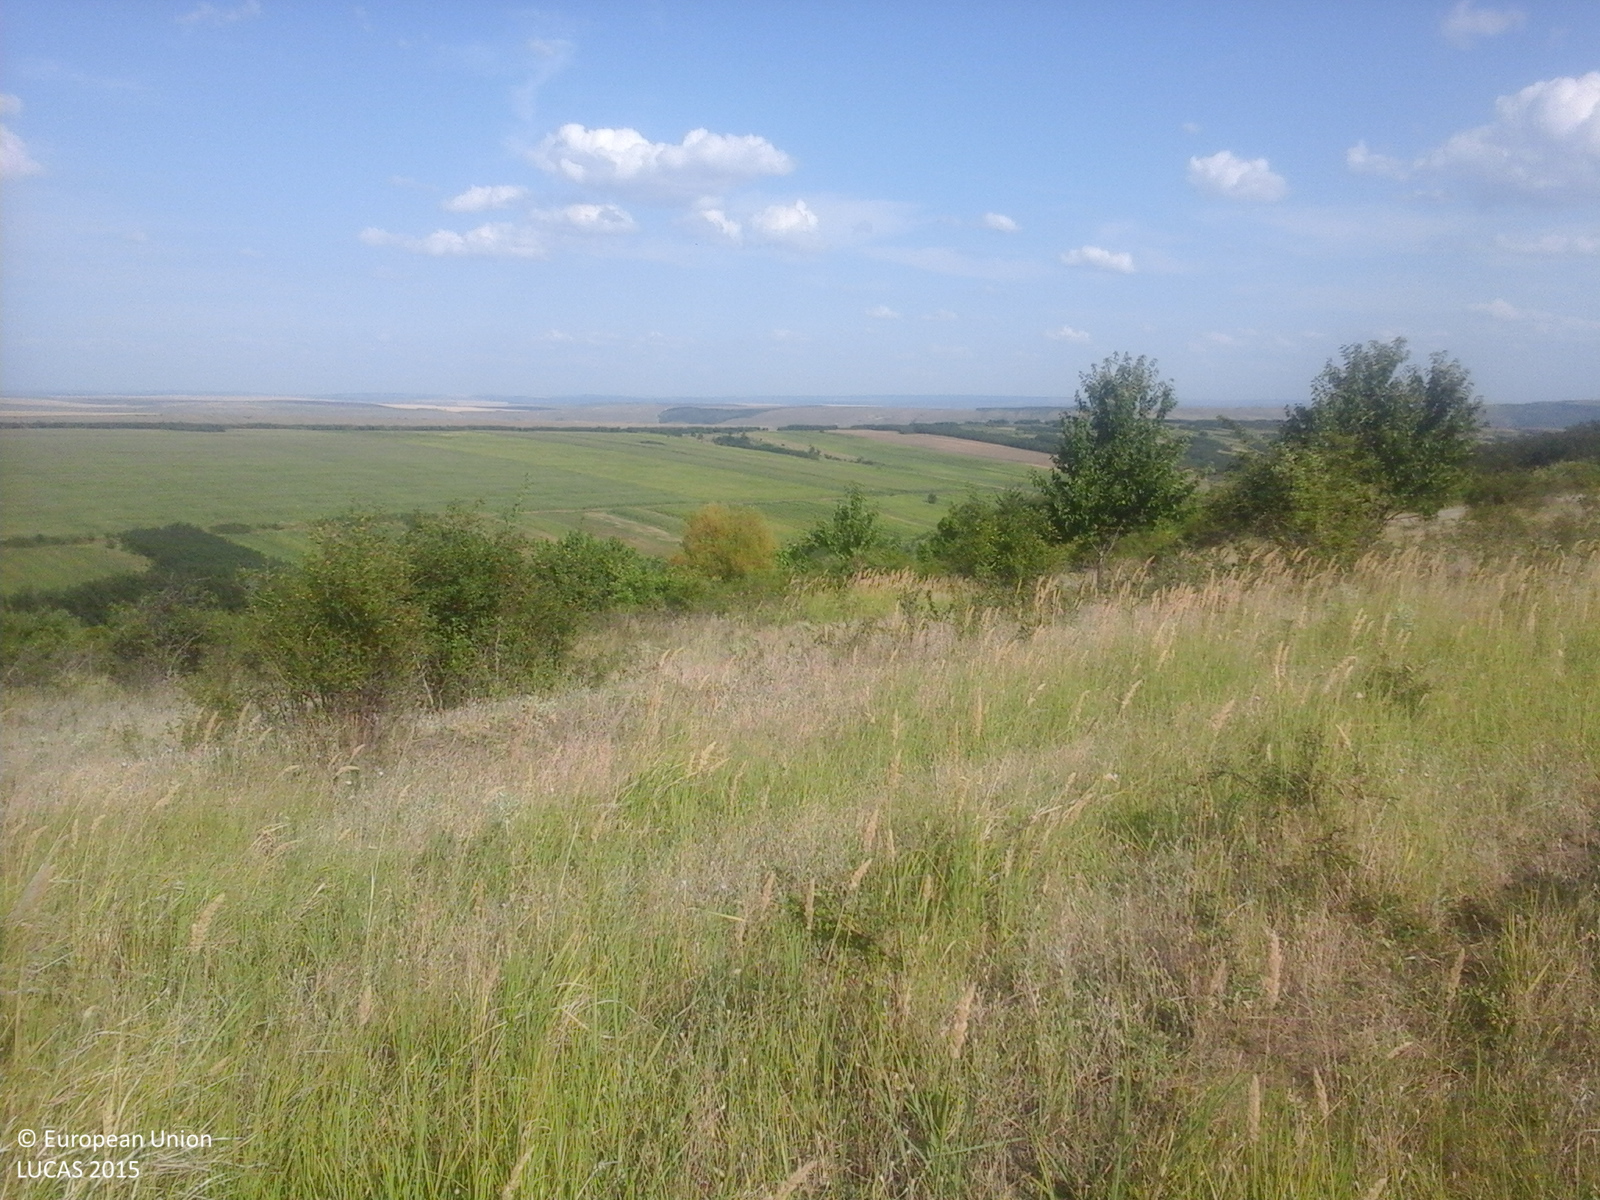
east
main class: Grassland
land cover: Grassland with sparse tree/shrub cover
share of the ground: > 75 %
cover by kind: herbaceous plants 85 %, shrubs 10 %, broadleaved forest trees 5 %
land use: Agriculture (excluding fallow land and kitchen gardens)
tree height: < 5 m
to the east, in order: Grassland with sparse tree/shrub cover; Tracks; Broadleaved woodland
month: July
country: RO
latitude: 46.4748
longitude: 27.9549
